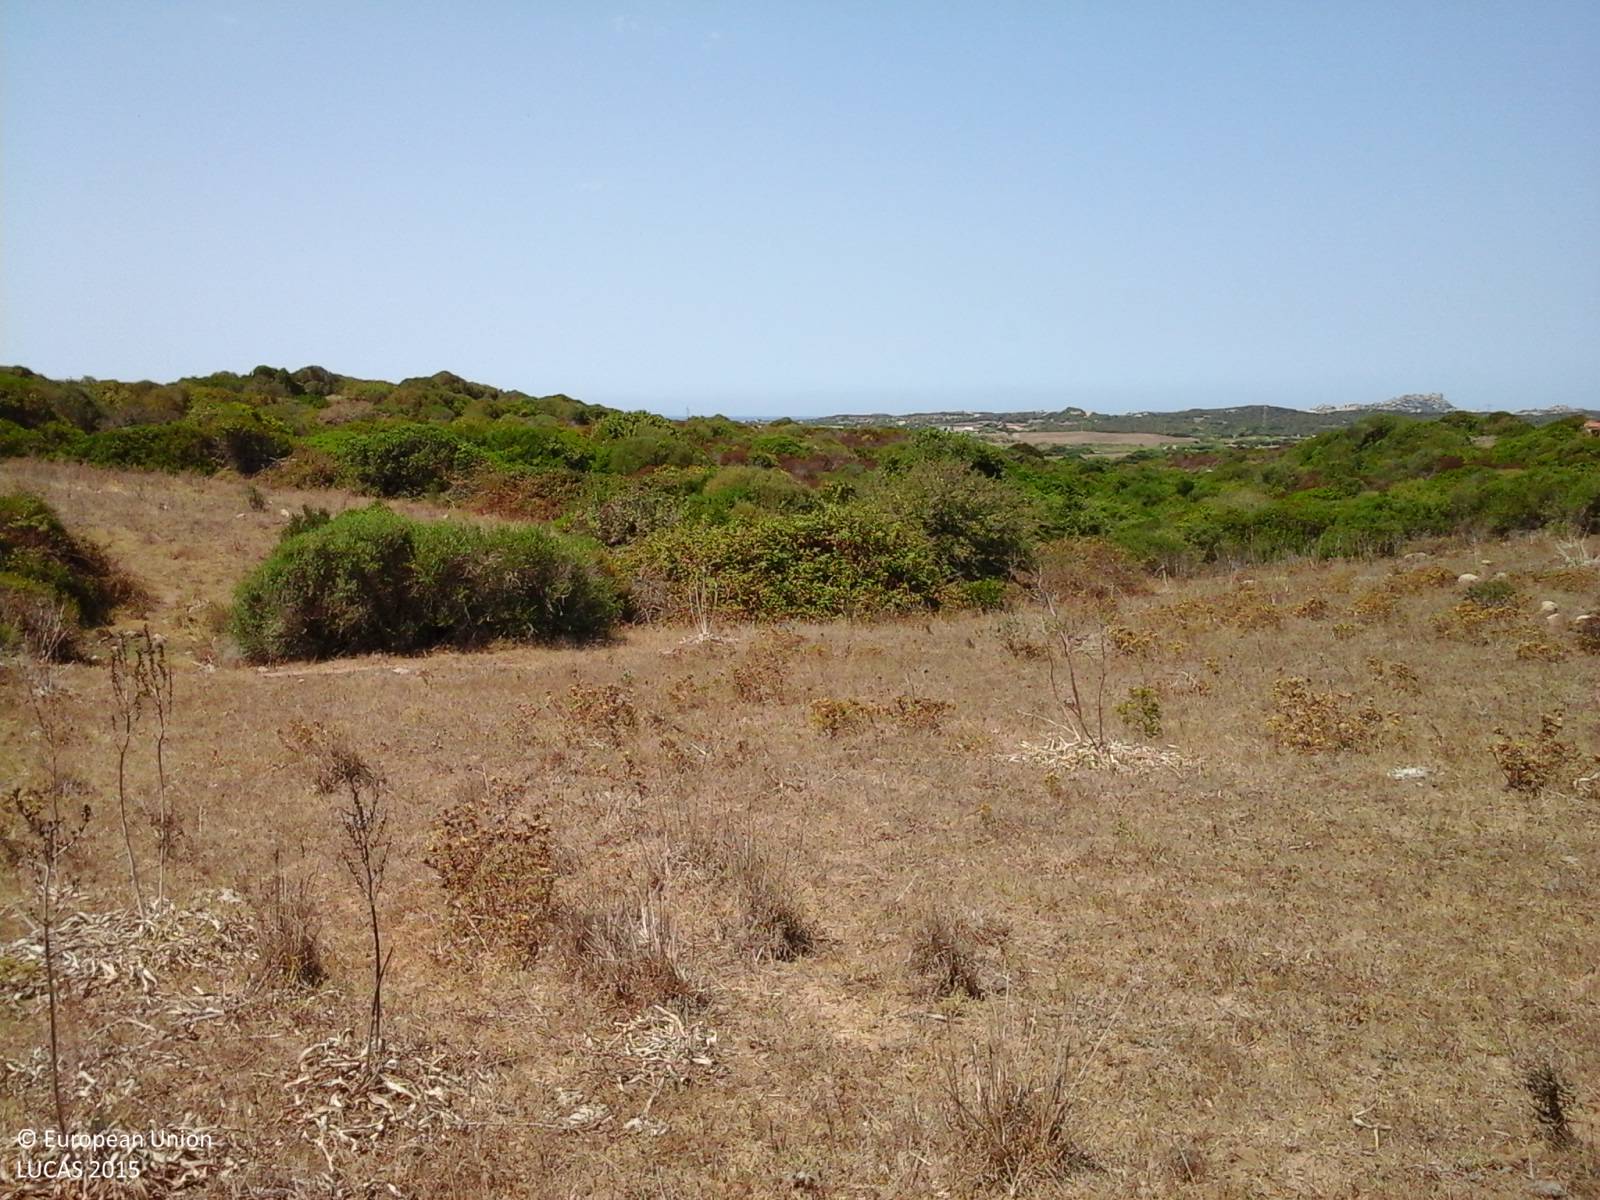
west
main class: Grassland
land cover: Grassland without tree/shrub cover
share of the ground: 25 - 50 %
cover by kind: herbaceous plants 100 %
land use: Agriculture (excluding fallow land and kitchen gardens)
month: July
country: IT
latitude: 41.2231
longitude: 9.2043
